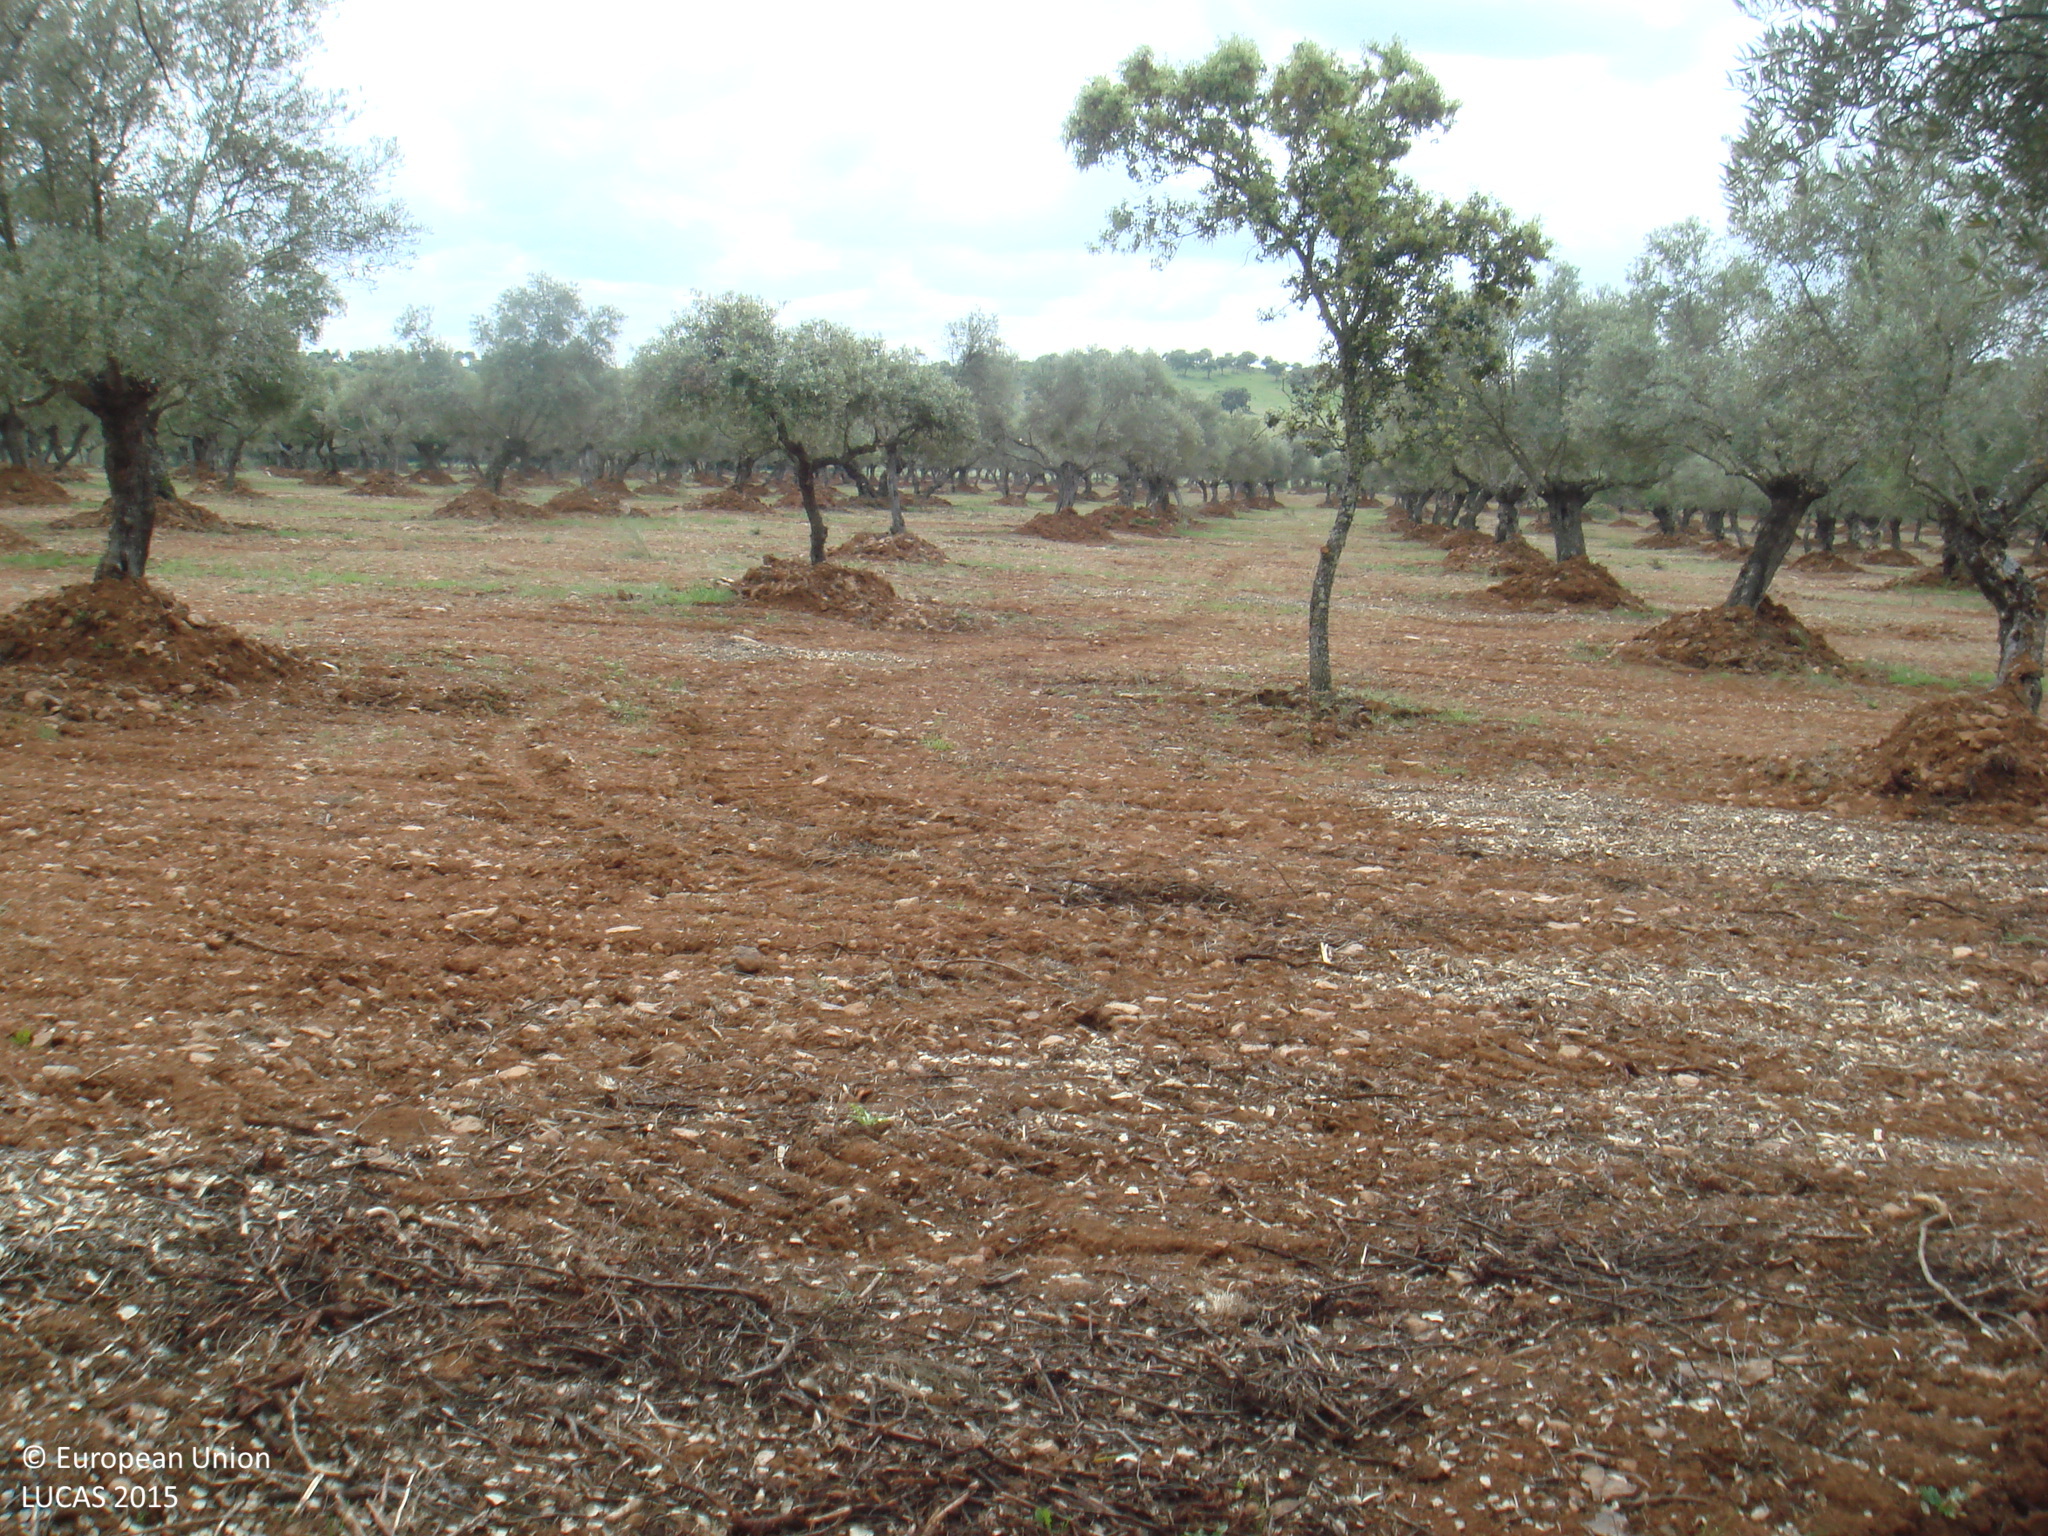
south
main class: Woodland
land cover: Broadleaved woodland
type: broadleaved evergreen forest
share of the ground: 25 - 50 %
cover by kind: broadleaved forest trees 40 %, shrubs 30 %, herbaceous plants 30 %
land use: Forestry
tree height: < 5 m
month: April
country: ES
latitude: 38.2639
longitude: -5.1002
